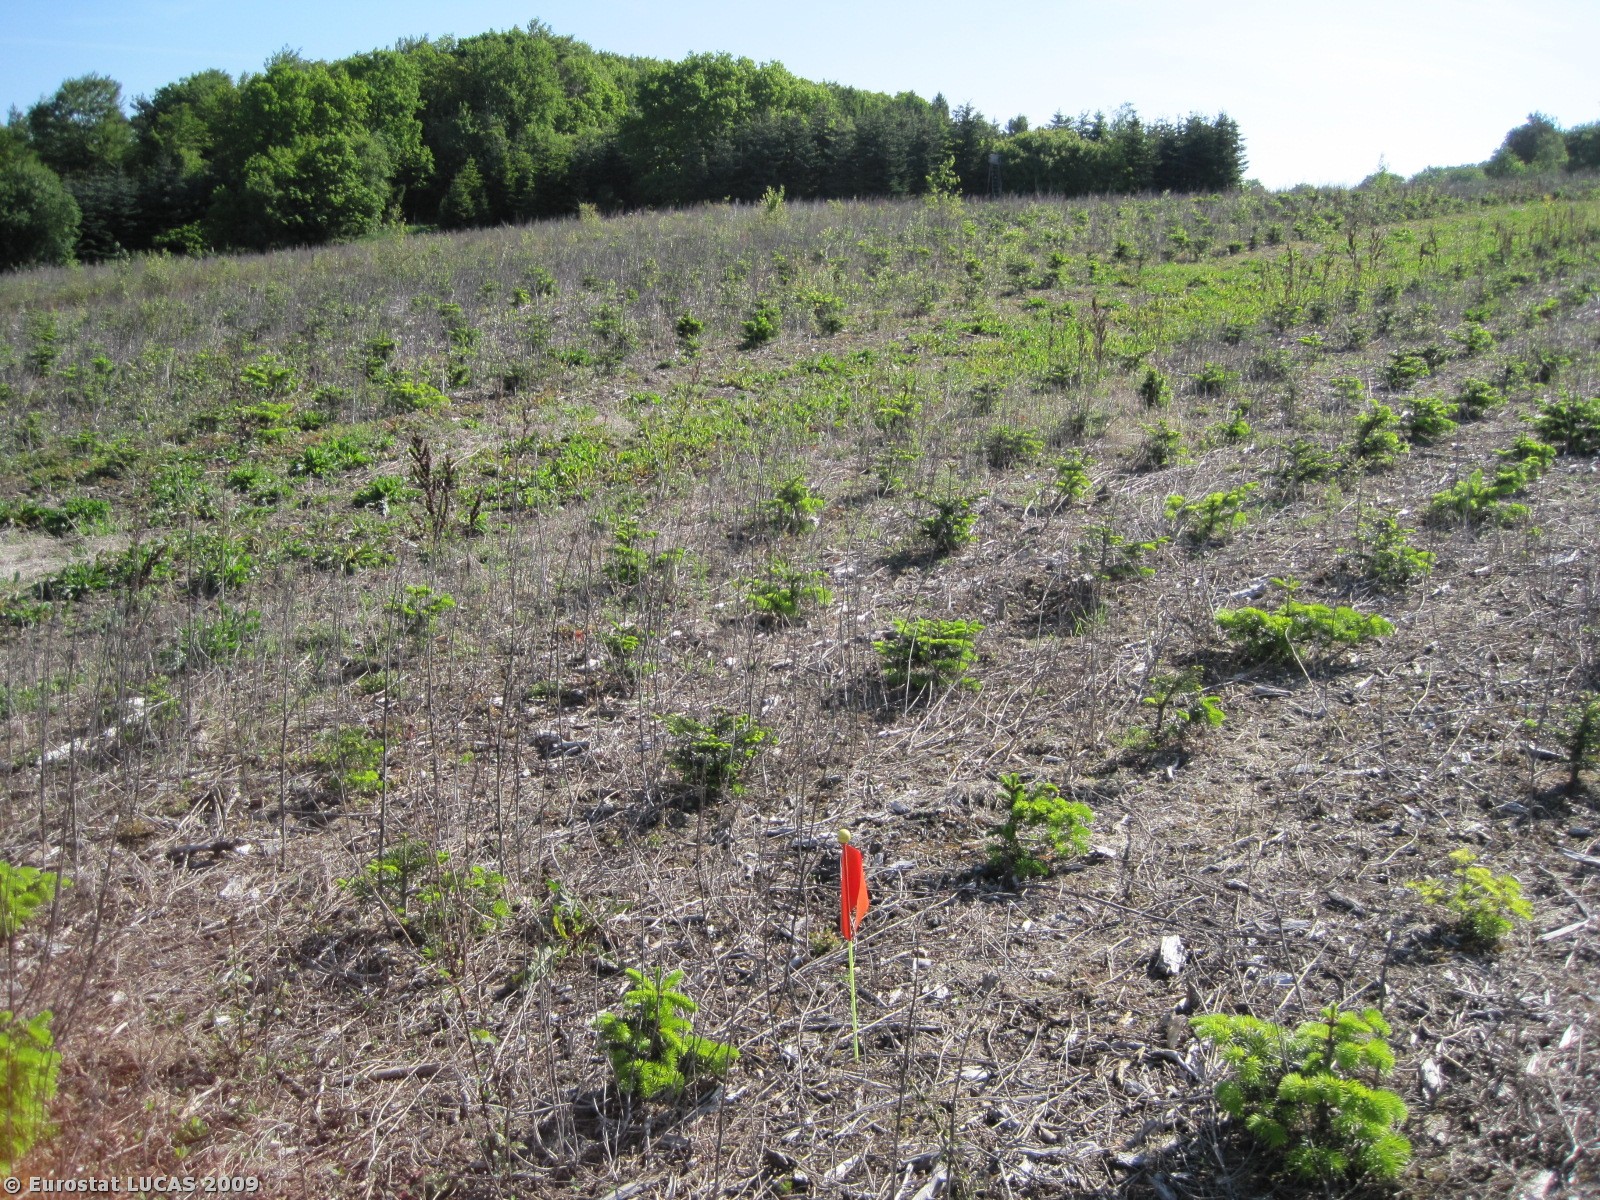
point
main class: Woodland
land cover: Coniferous woodland
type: plantations and self-sown exotic forest
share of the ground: < 10 %
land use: Forestry
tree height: > 5 m
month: May
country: DK
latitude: 56.5292
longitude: 10.1461
